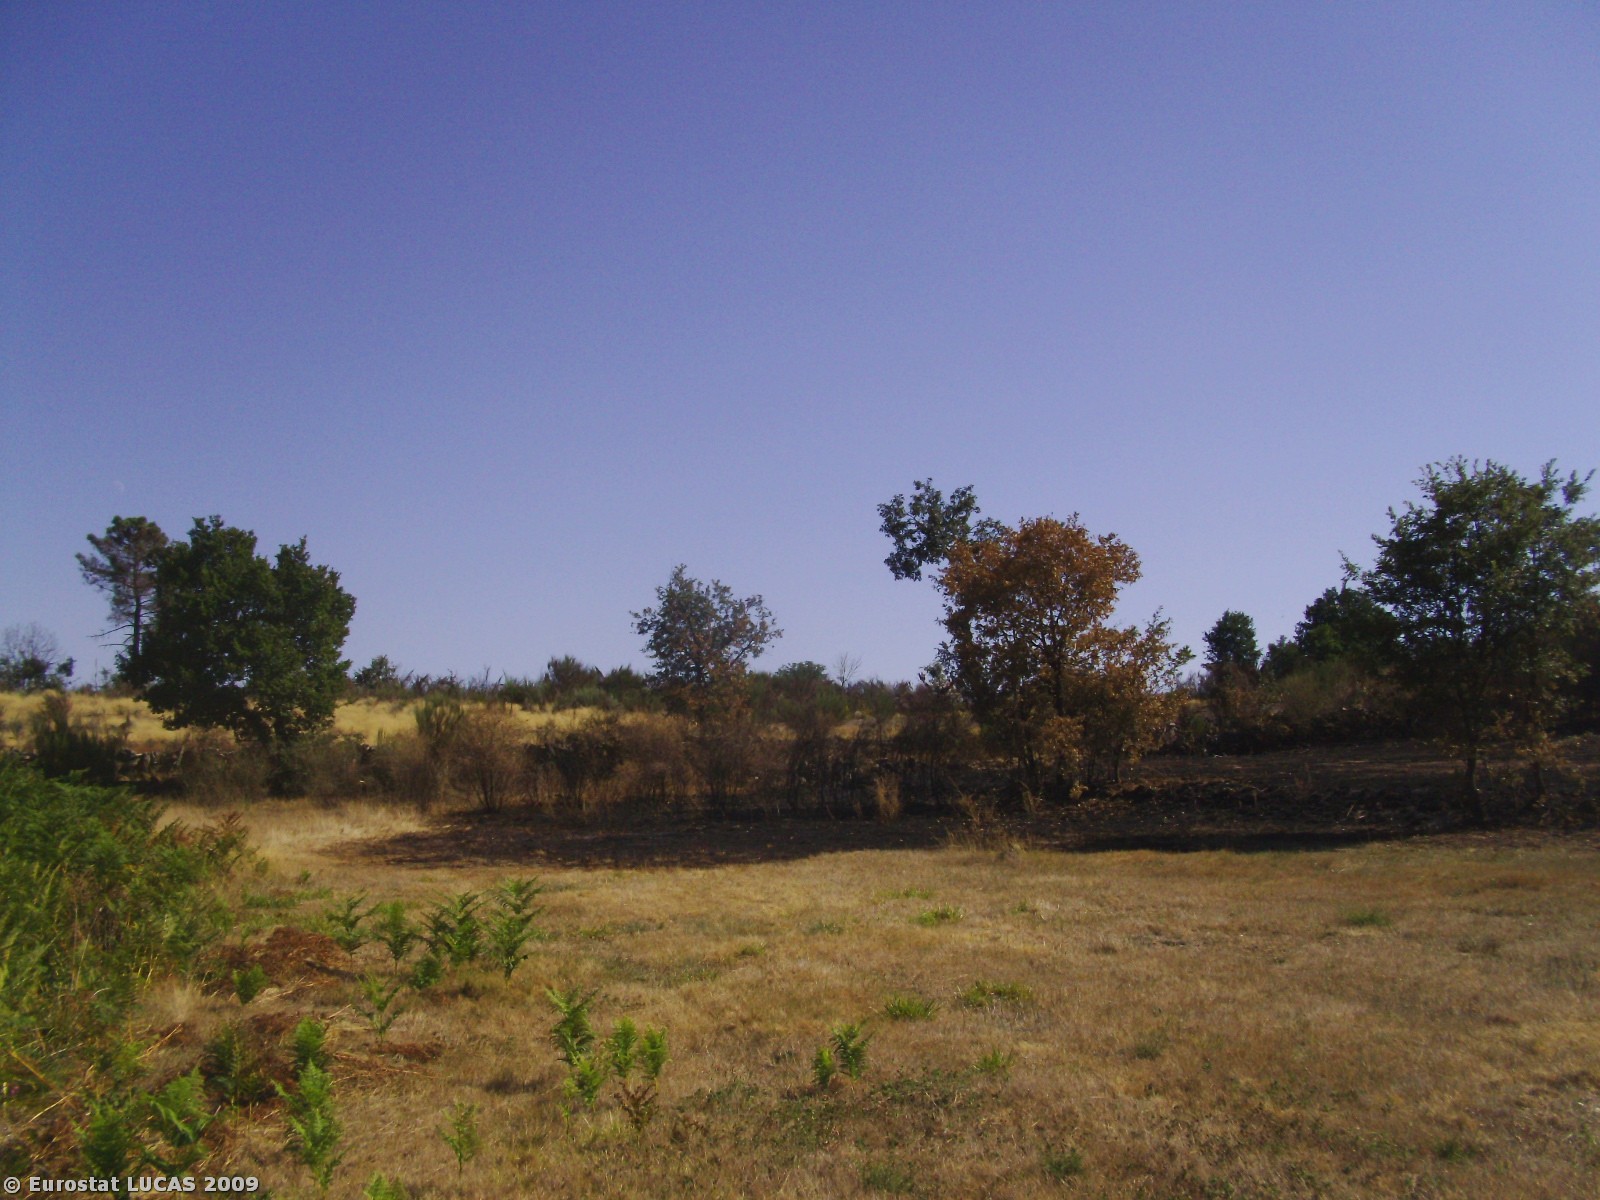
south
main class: Grassland
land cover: Spontaneously vegetated surfaces
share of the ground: > 75 %
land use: Fallow land
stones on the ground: < 10 %
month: August
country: PT
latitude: 41.7430
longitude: -7.6054
